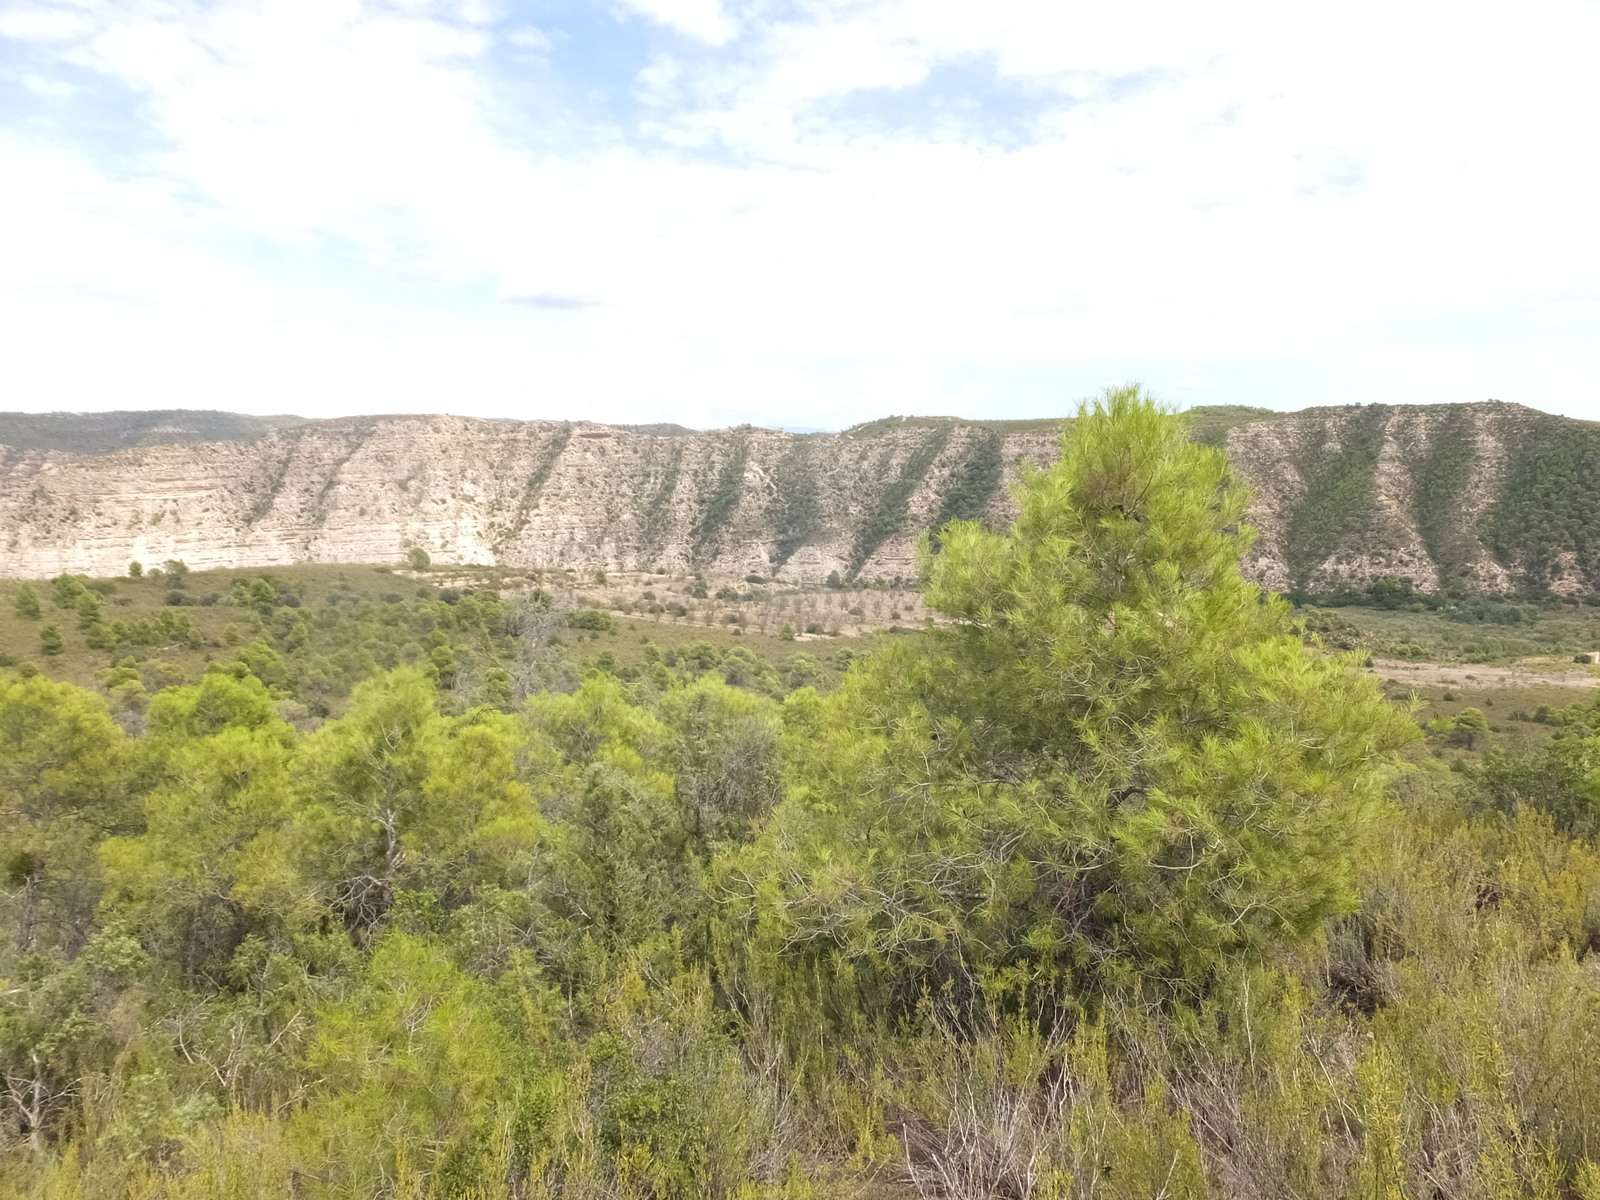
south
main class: Woodland
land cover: Pine dominated mixed woodland
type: coniferous forest of the mediterranean region
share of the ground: 50 - 75 %
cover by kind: coniferous forest trees 60 %, broadleaved forest trees 20 %, shrubs 20 %
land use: Forestry
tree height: > 5 m
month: August
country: ES
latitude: 41.2407
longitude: 0.2884
